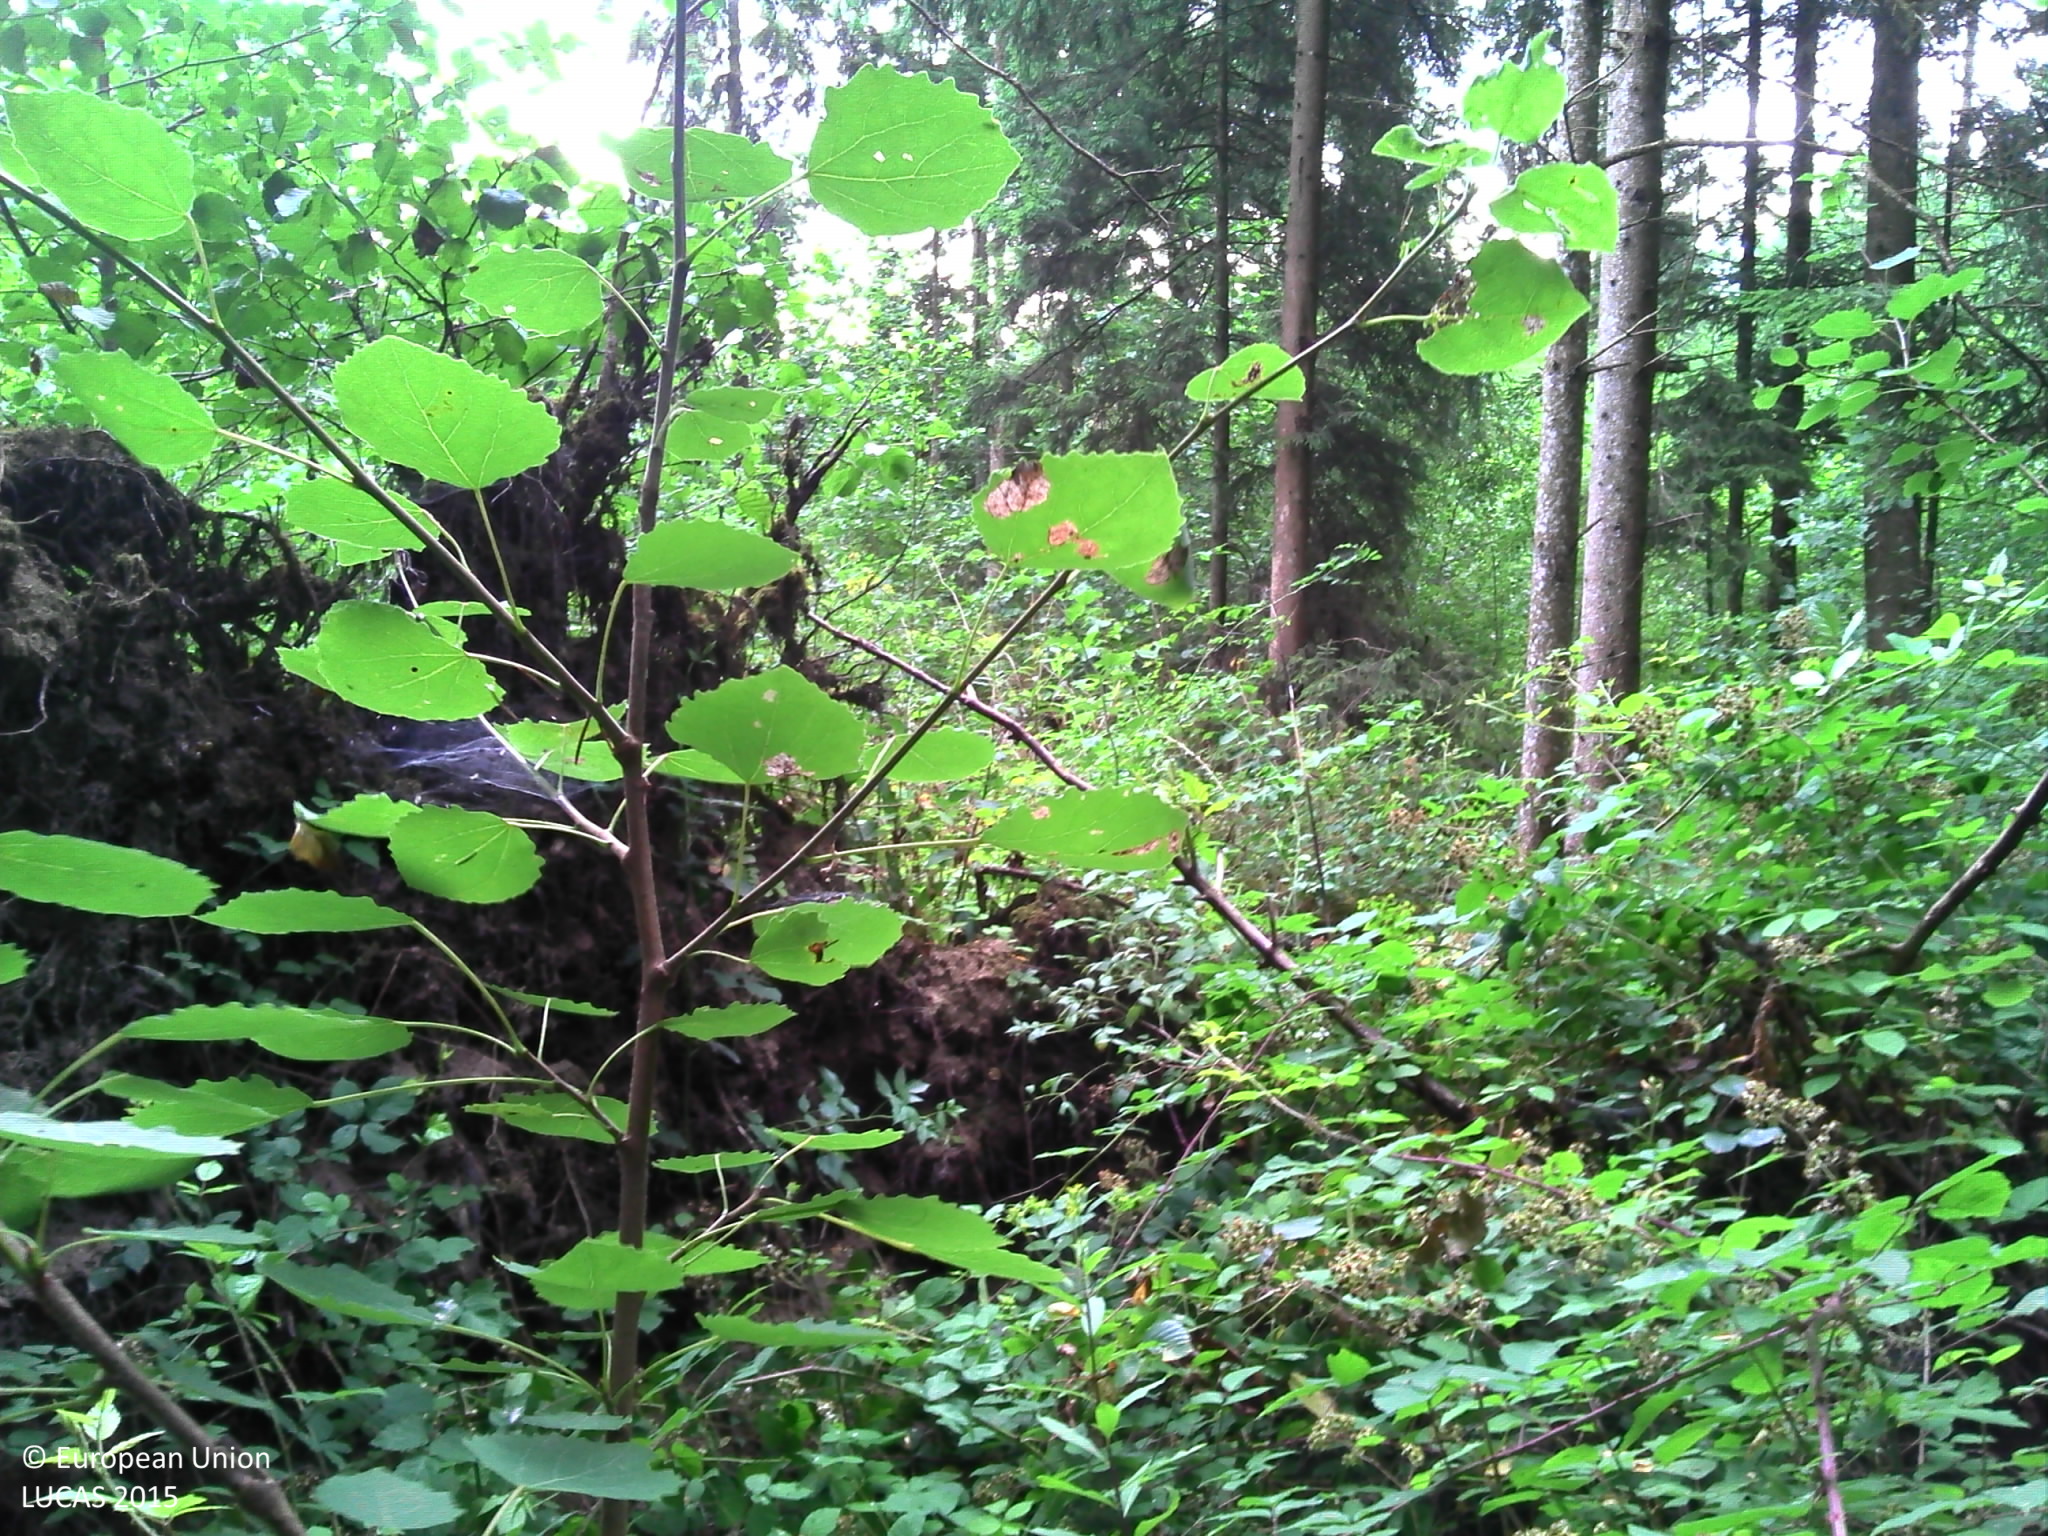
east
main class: Woodland
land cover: Spruce dominated coniferous woodland
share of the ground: 50 - 75 %
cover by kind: coniferous forest trees 60 %, shrubs 25 %, herbaceous plants 10 %, broadleaved forest trees 5 %
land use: Forestry
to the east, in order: Spruce dominated coniferous woodland; Shrubland with sparse tree cover; Broadleaved woodland
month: July
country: BE
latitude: 49.6875
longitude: 5.6602
